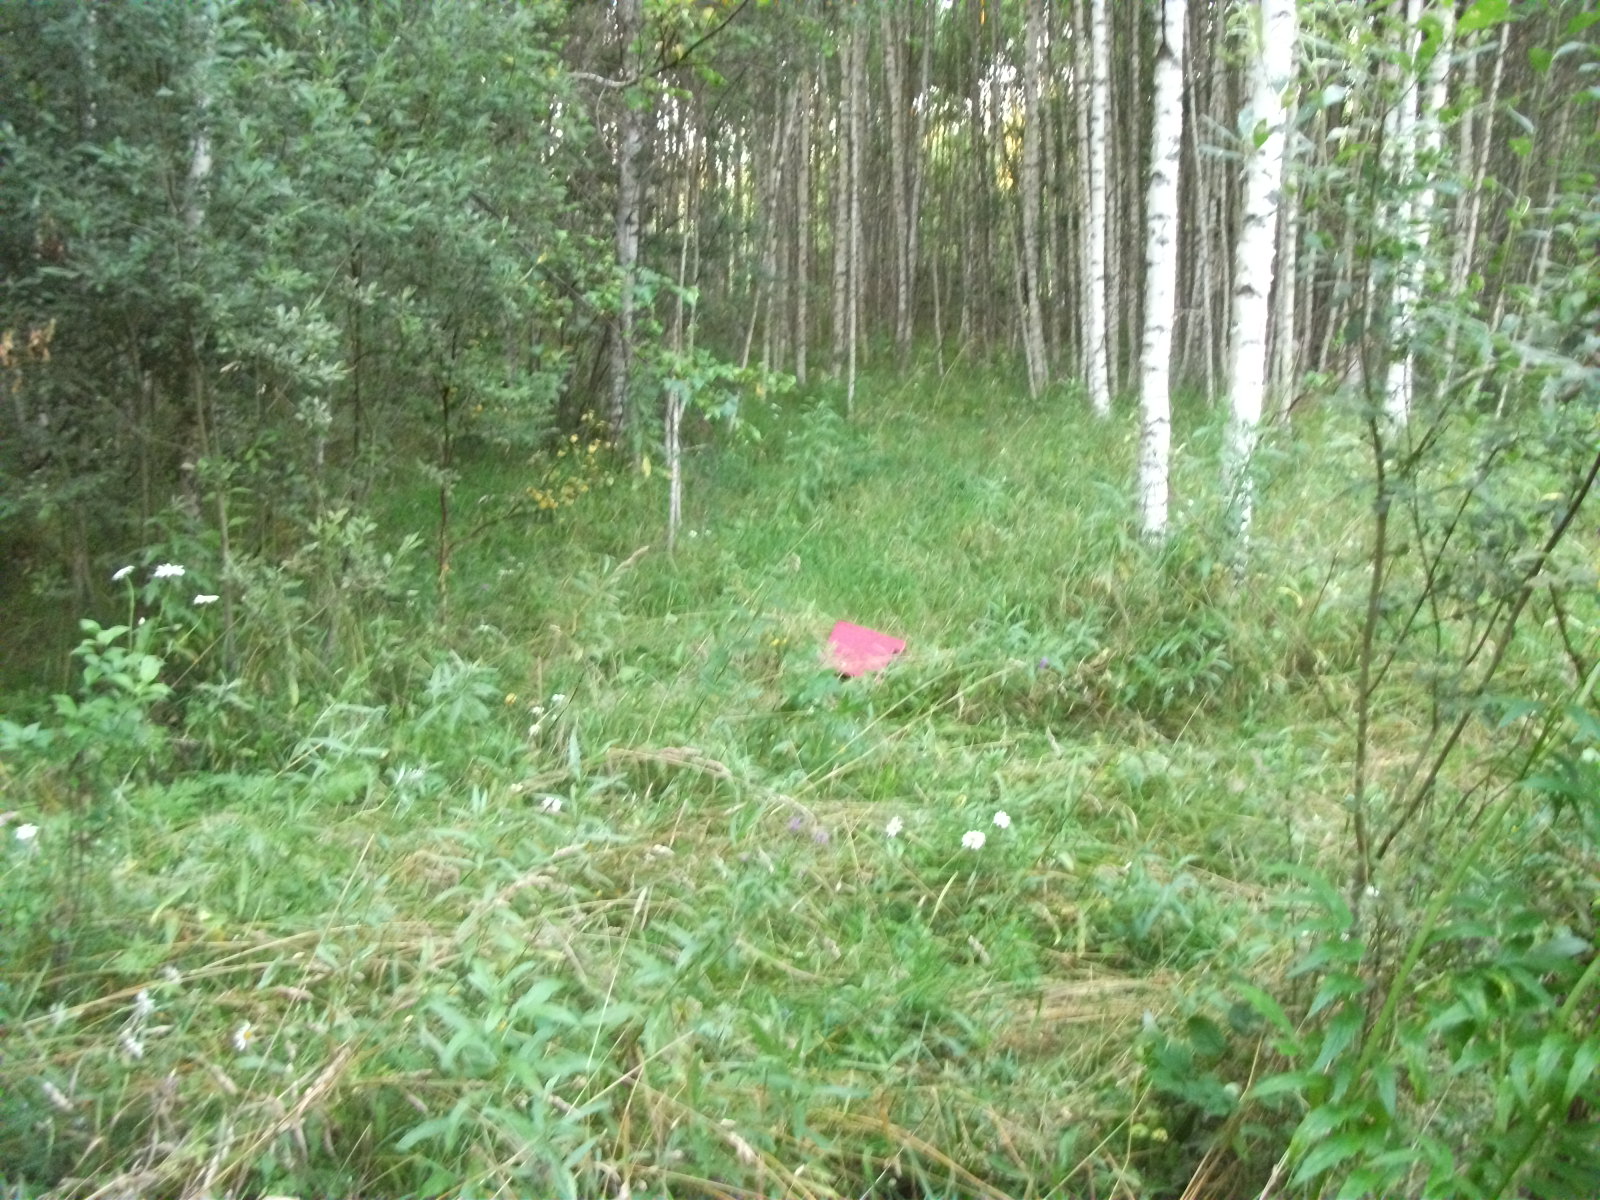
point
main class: Woodland
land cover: Broadleaved woodland
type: non-riverine alder, birch or aspen forest
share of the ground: > 75 %
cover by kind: broadleaved forest trees 80 %, herbaceous plants 15 %, shrubs 5 %
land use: Forestry
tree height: > 5 m
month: August
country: LV
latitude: 56.7693
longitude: 25.5827
